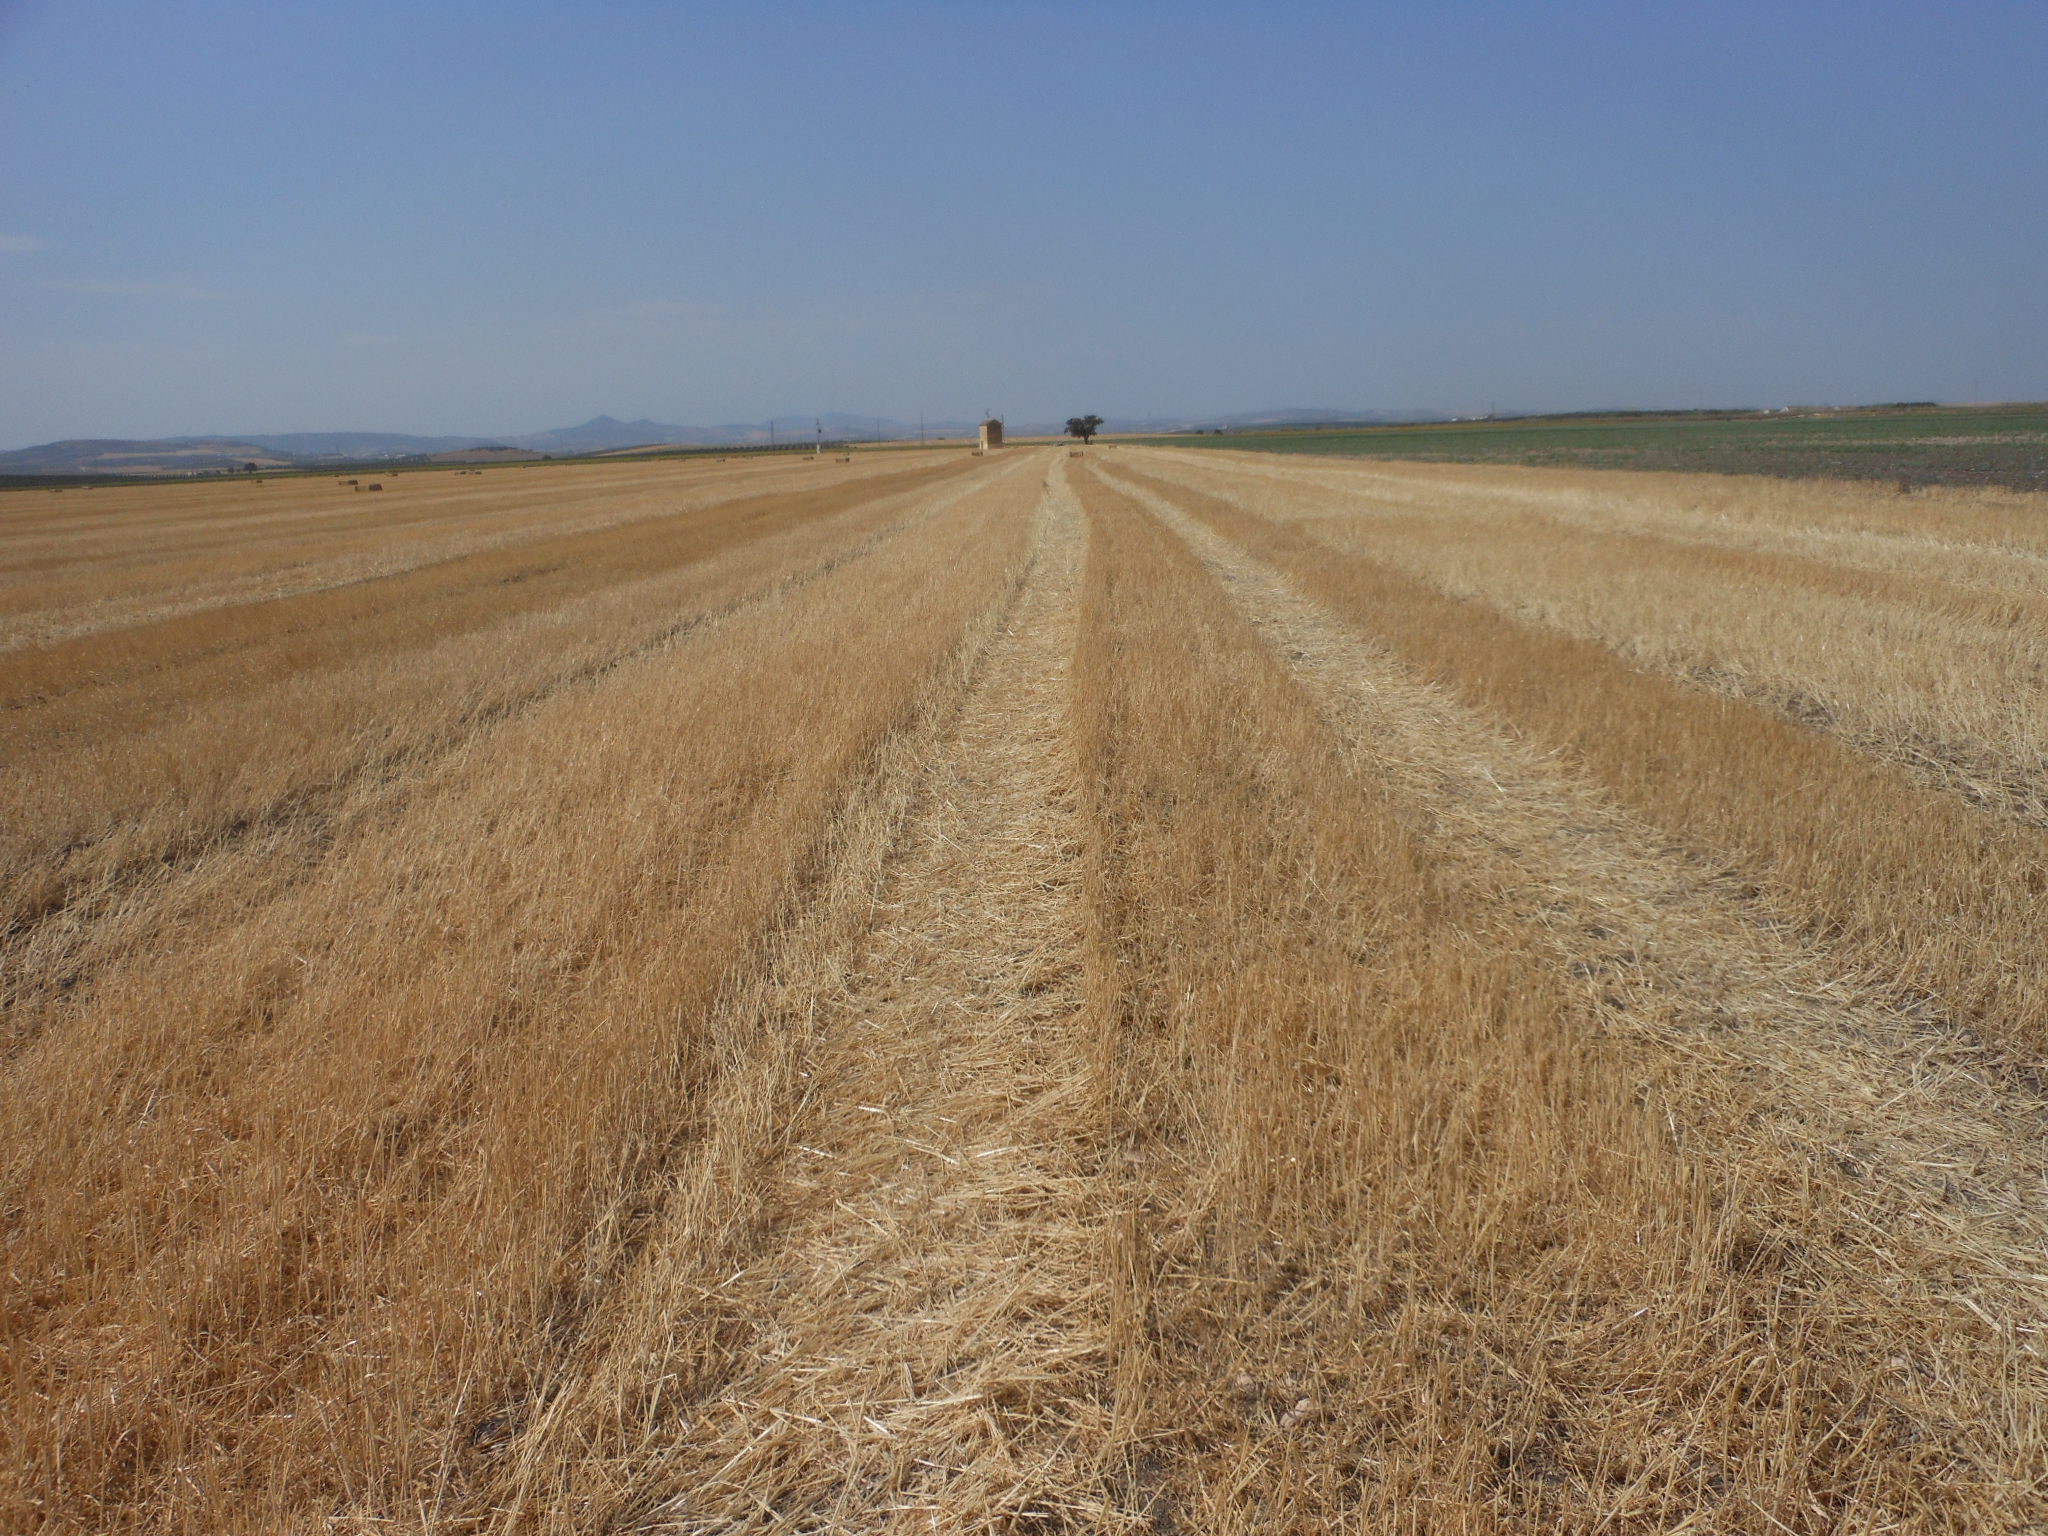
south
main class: Cropland
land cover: Common wheat
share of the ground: < 10 %
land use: Agriculture (excluding fallow land and kitchen gardens)
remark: Harvested field
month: June
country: ES
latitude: 37.3226
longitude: -5.1197
